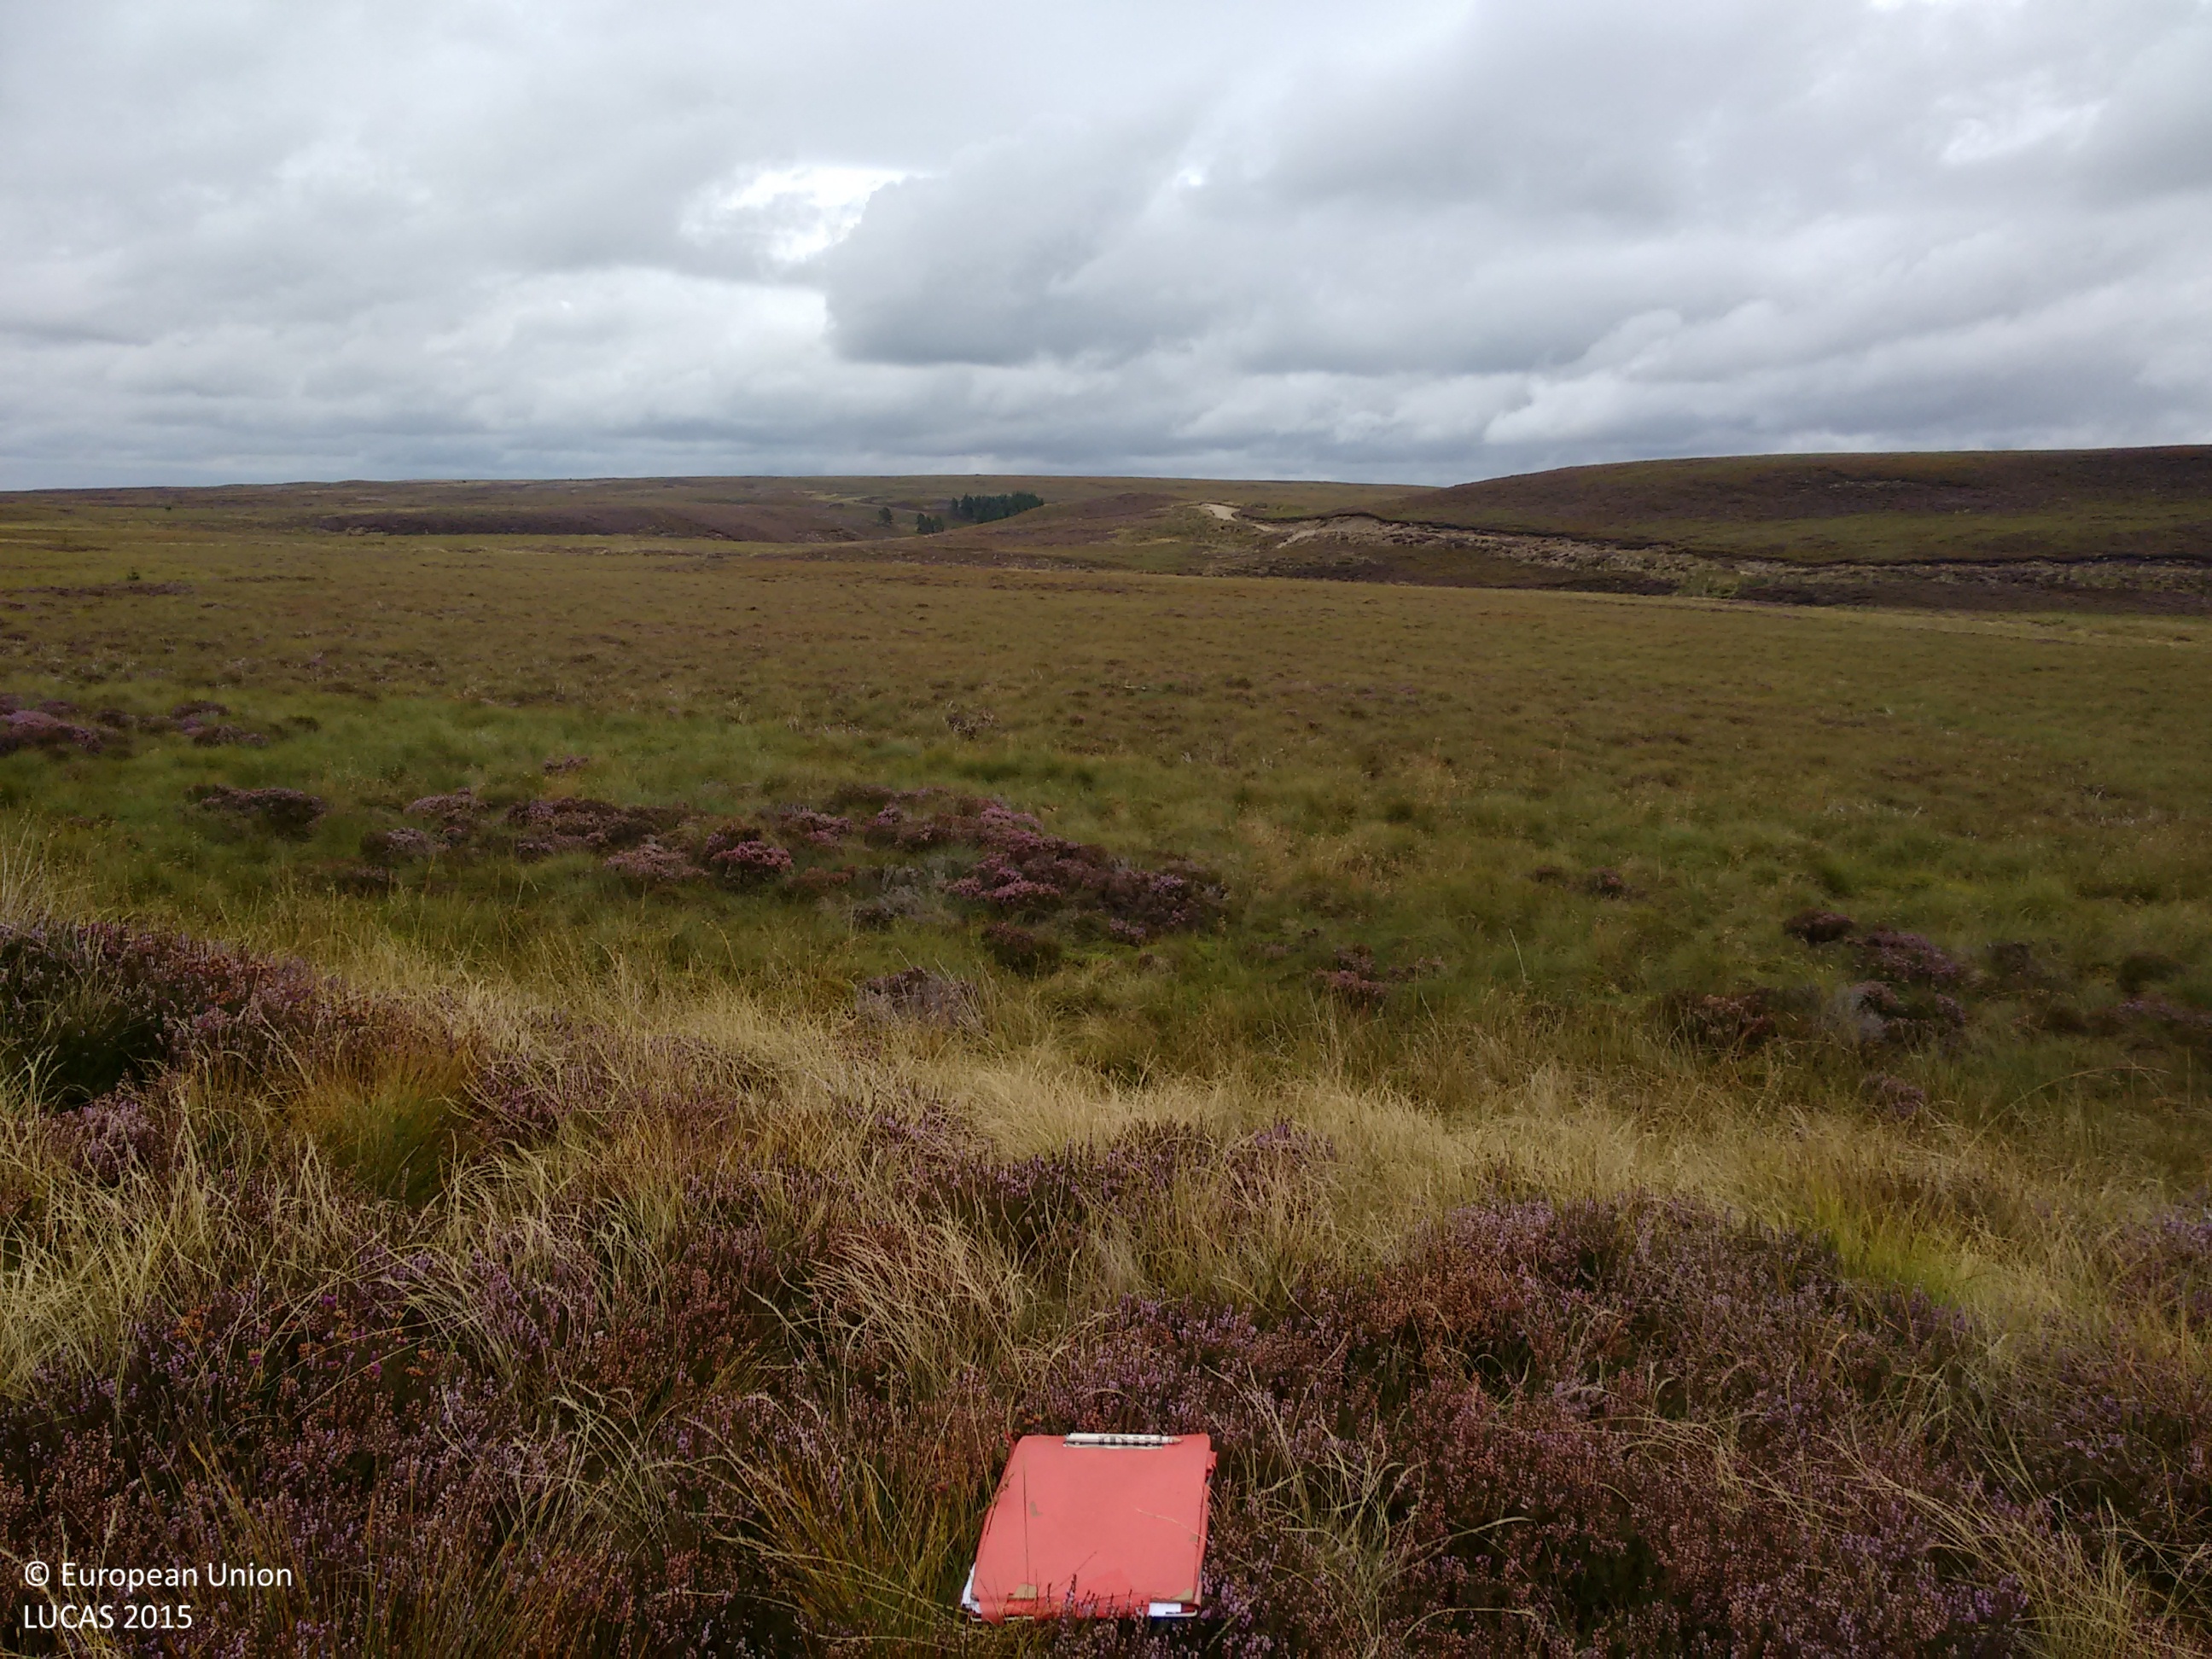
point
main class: Shrubland
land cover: Shrubland without tree cover
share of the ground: > 75 %
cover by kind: shrubs 80 %, herbaceous plants 20 %
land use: Agriculture (excluding fallow land and kitchen gardens)
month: September
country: GB
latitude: 57.4562
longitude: -3.8955
